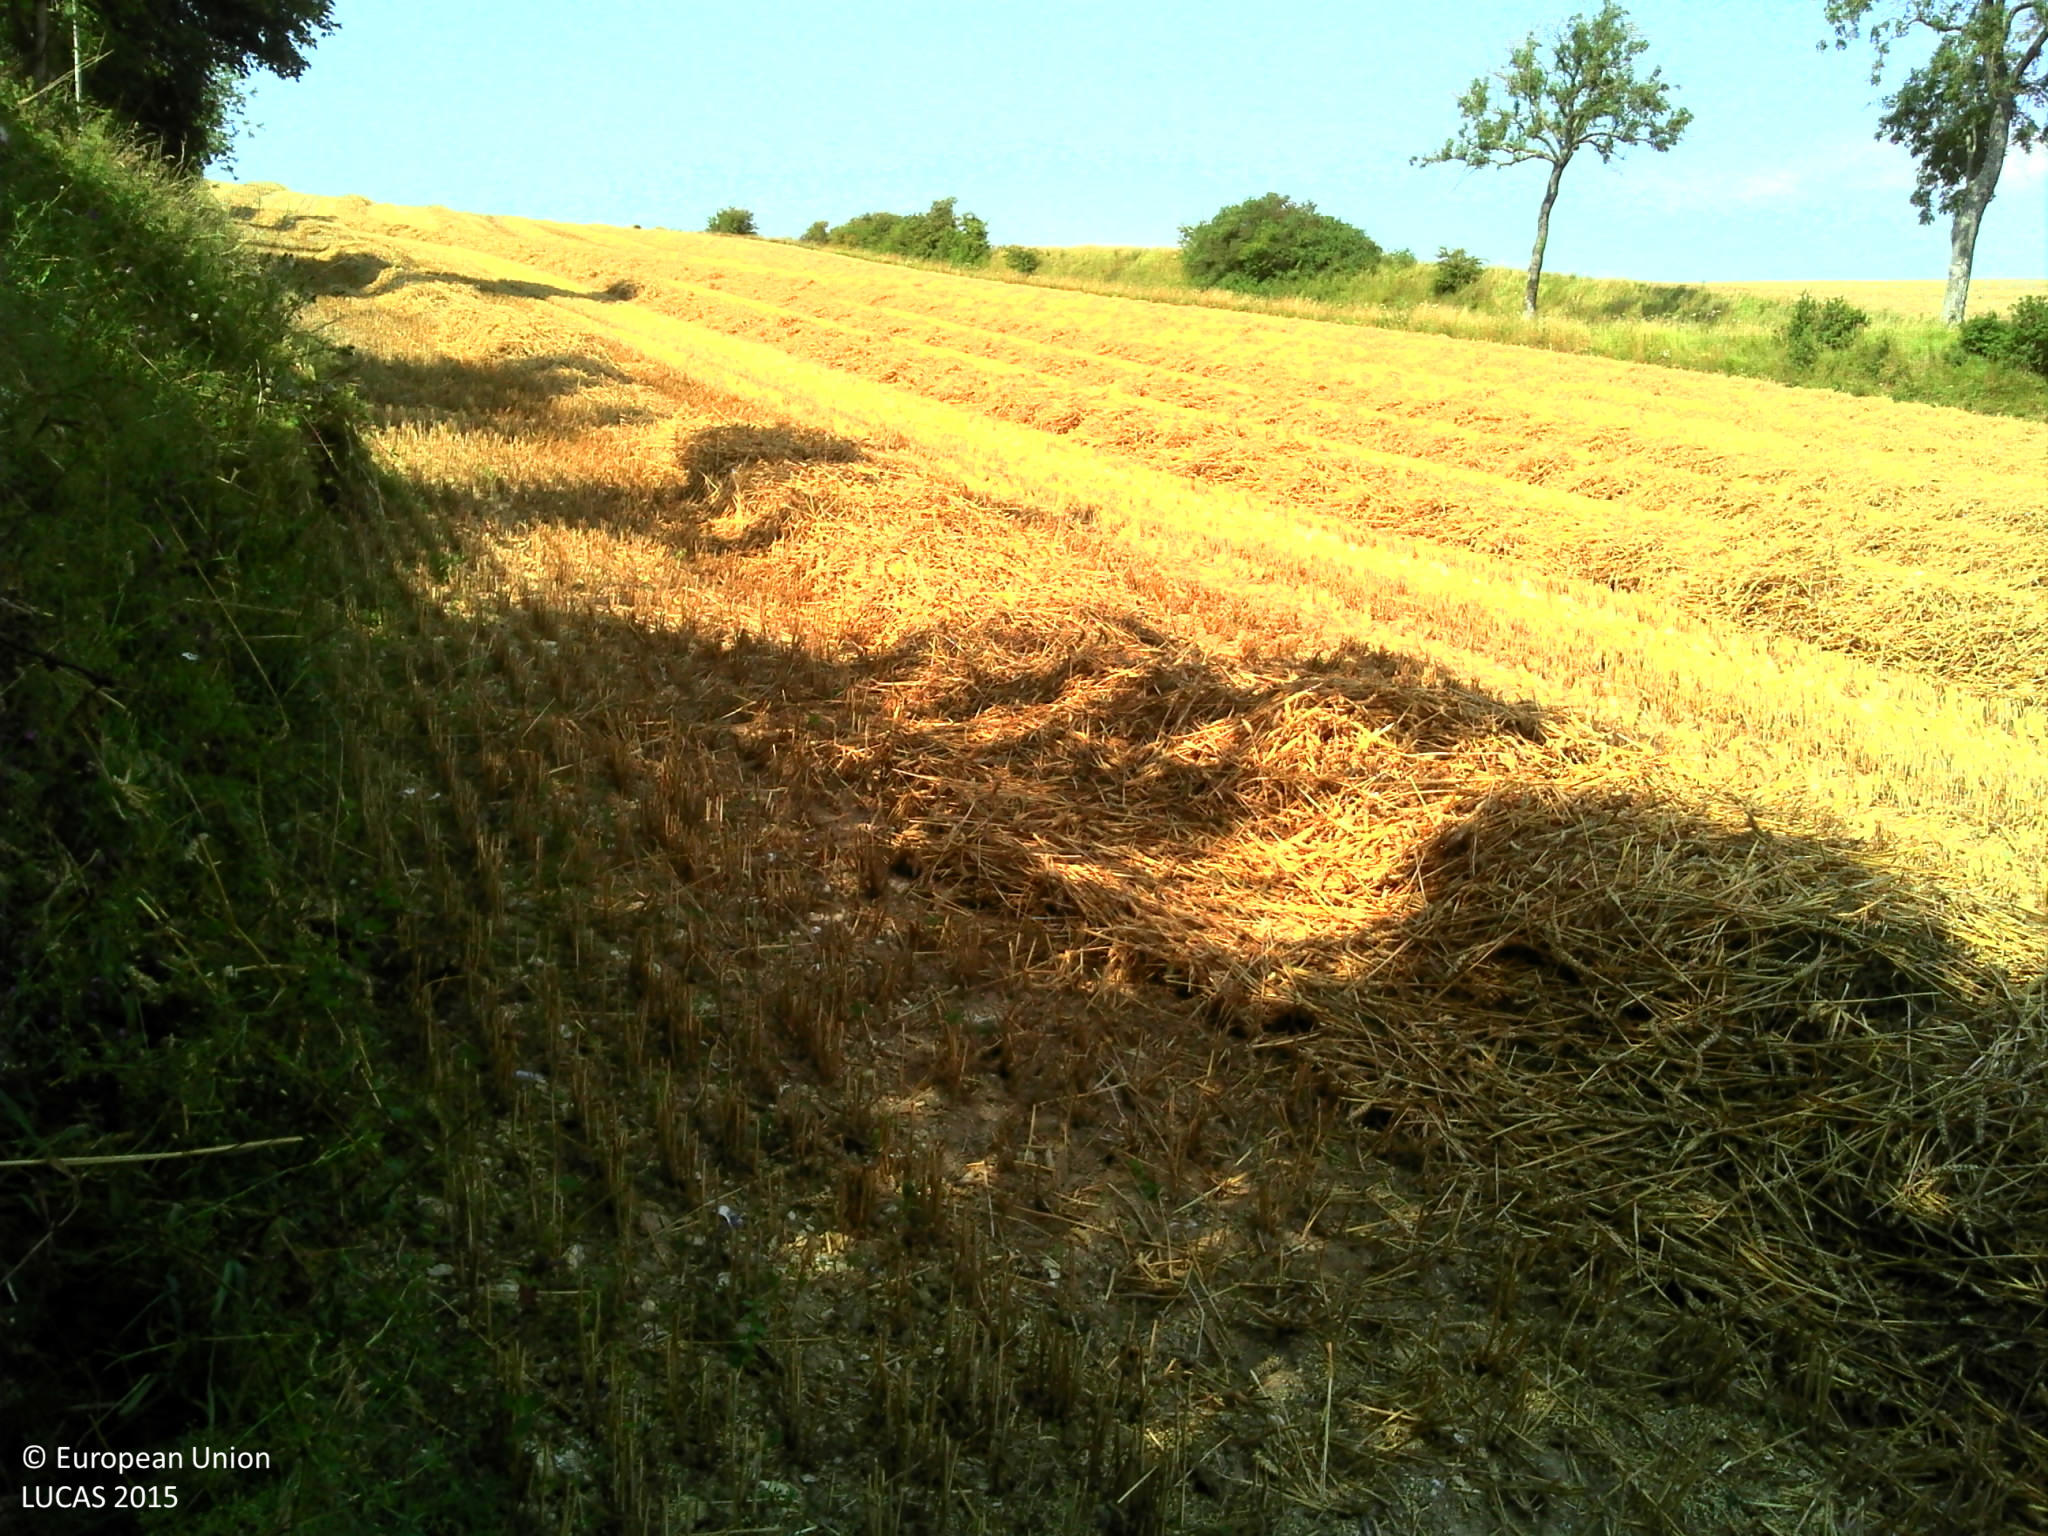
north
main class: Cropland
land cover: Common wheat
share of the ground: > 75 %
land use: Agriculture (excluding fallow land and kitchen gardens)
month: August
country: FR
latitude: 50.8080
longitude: 2.0231
